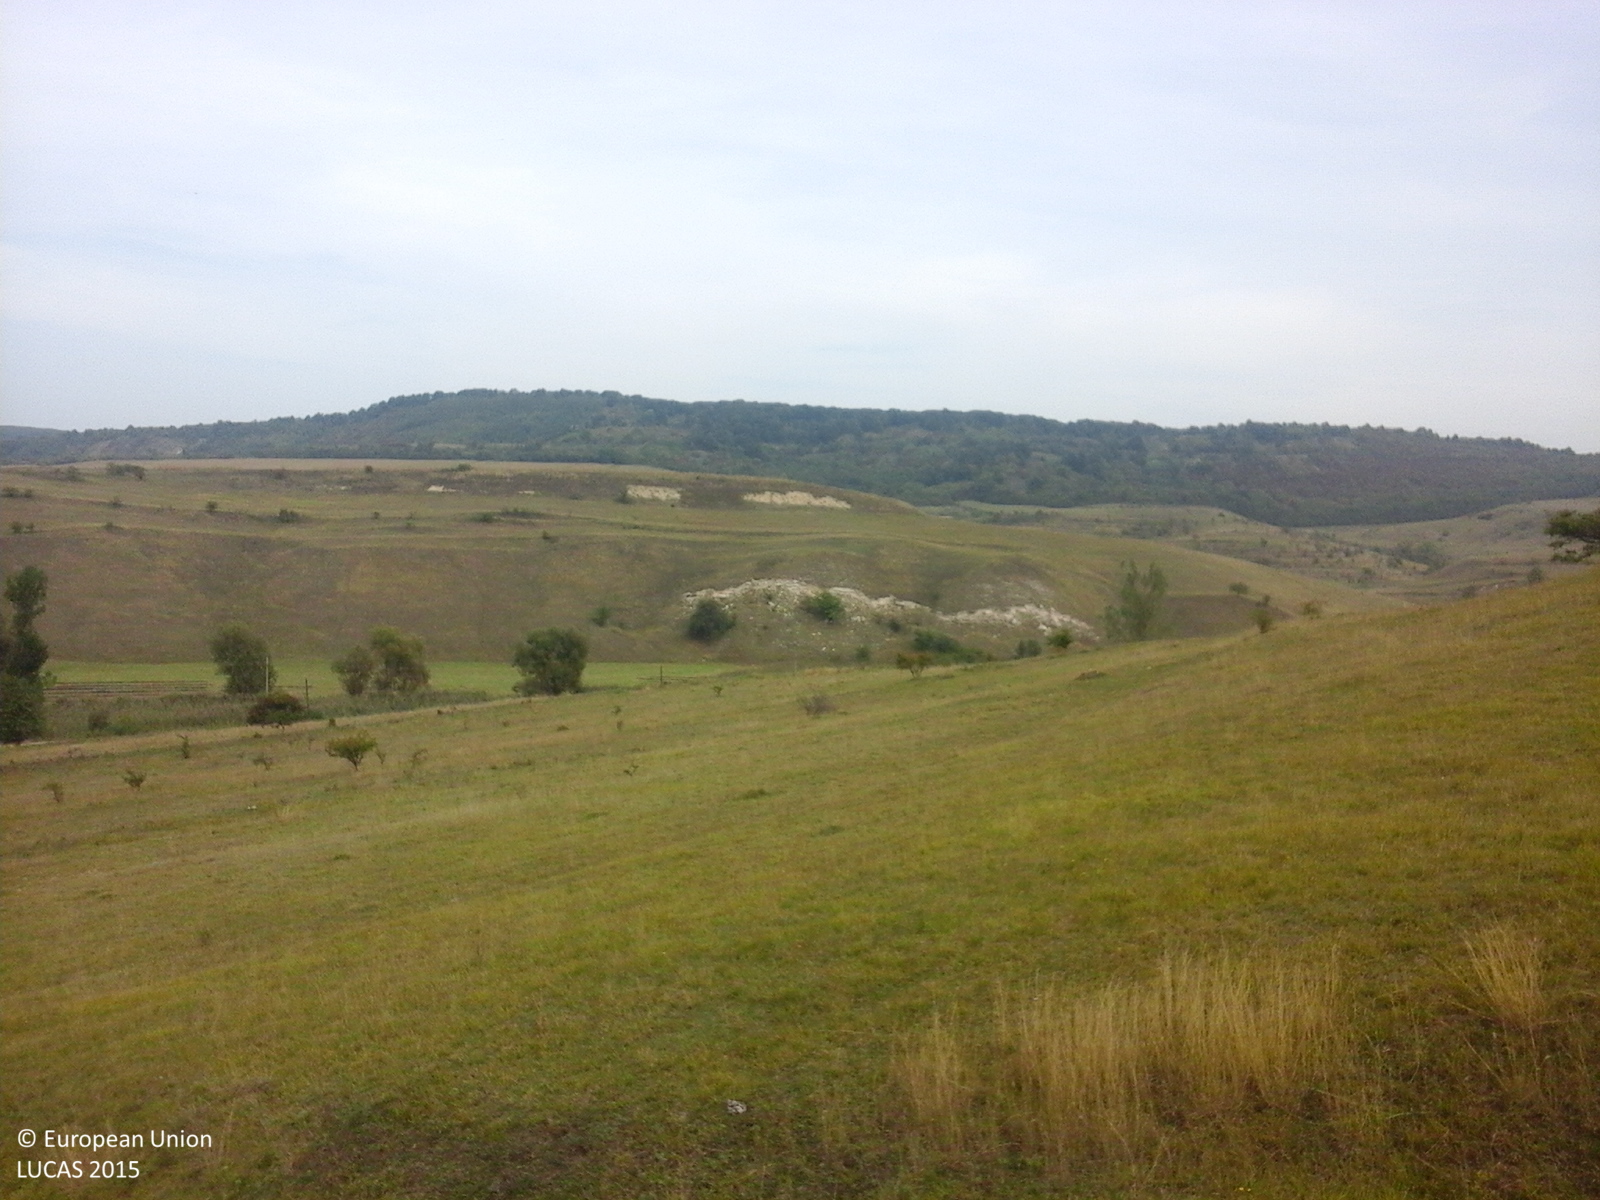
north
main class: Grassland
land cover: Grassland without tree/shrub cover
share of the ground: > 75 %
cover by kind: herbaceous plants 100 %
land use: Agriculture (excluding fallow land and kitchen gardens)
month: September
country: RO
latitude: 46.8882
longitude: 23.1218
